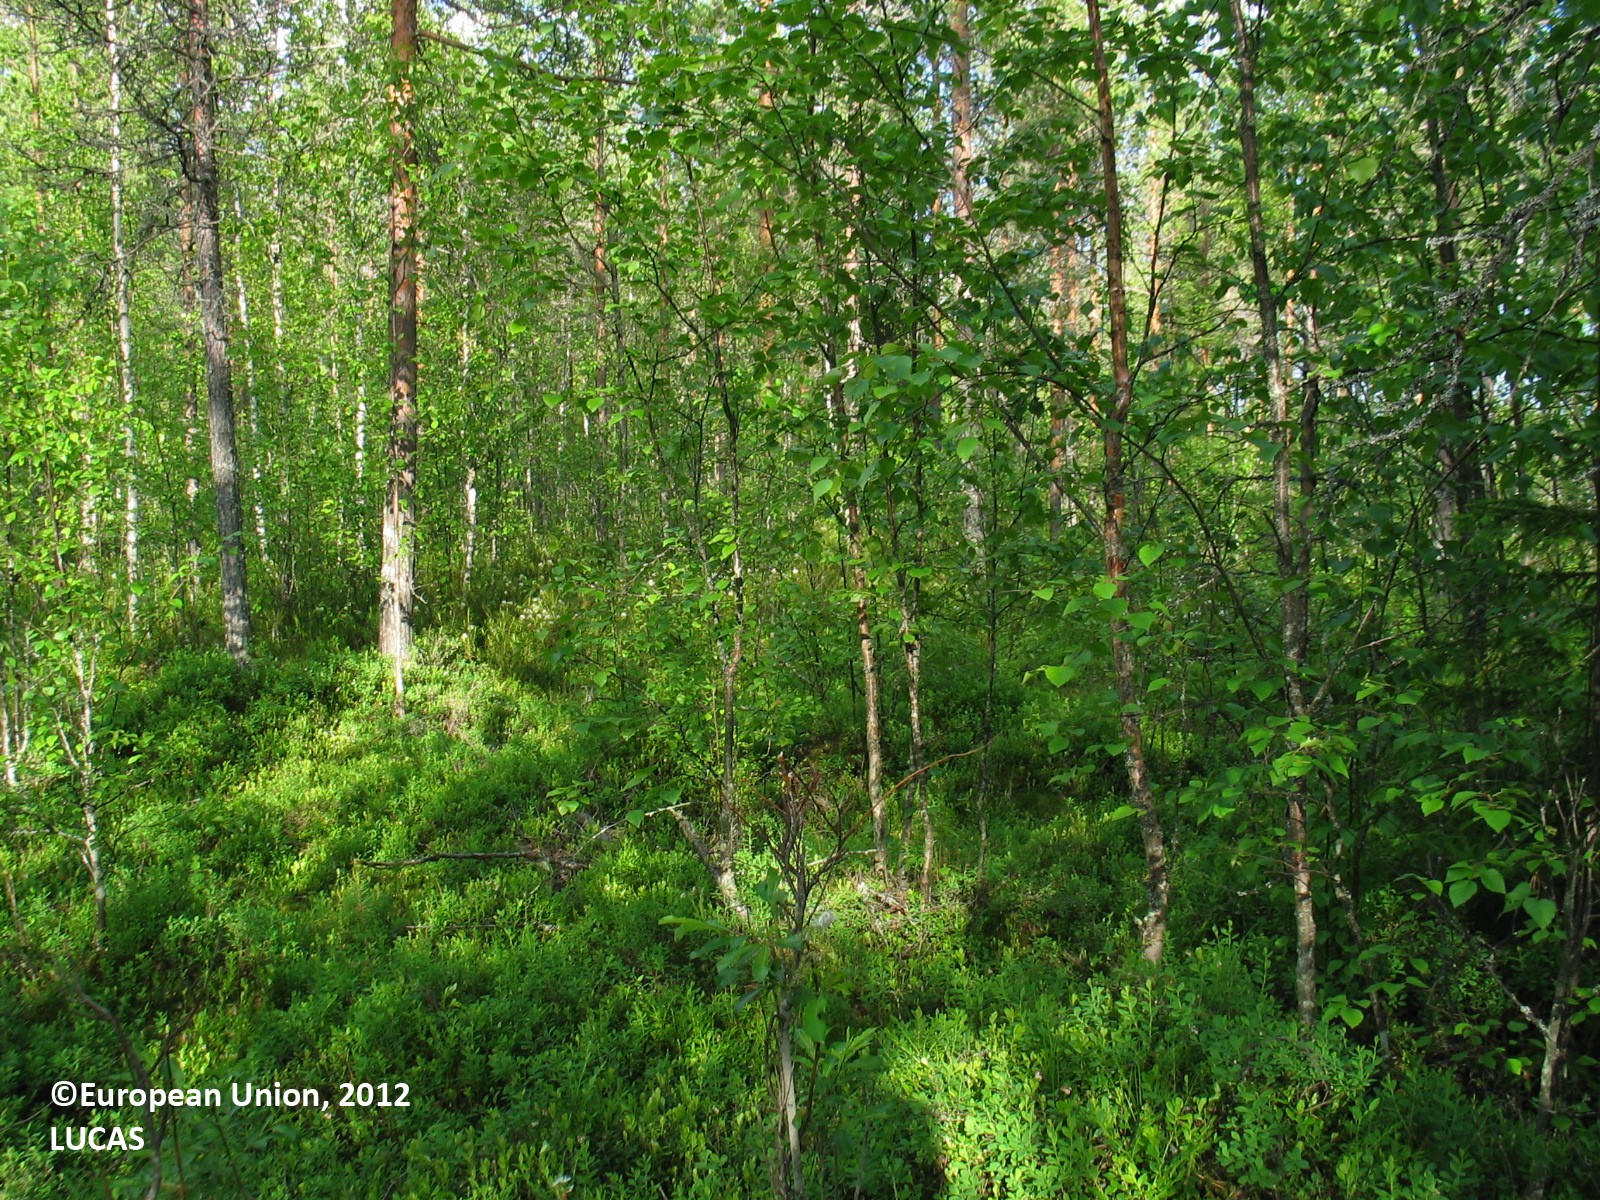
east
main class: Woodland
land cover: Pine dominated mixed woodland
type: boreal forest
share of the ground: 50 - 75 %
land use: Forestry
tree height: > 5 m
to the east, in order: Pine dominated mixed woodland; Other mixed woodland; Ditches and canals; Broadleaved woodland; Ditches and canals; Groves; Paved roads, cycling and walking lanes; Groves; Ditches and canals; Other mixed woodland; Shrubland with sparse tree cover; Ditches and canals; Shrubland without tree cover; Ditches and canals; Shrubland without tree cover; Ditches and canals; Shrubland without tree cover; Ditches and canals; Shrubland without tree cover; Pine dominated coniferous woodland
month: June
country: FI
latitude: 64.8044
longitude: 26.6842
